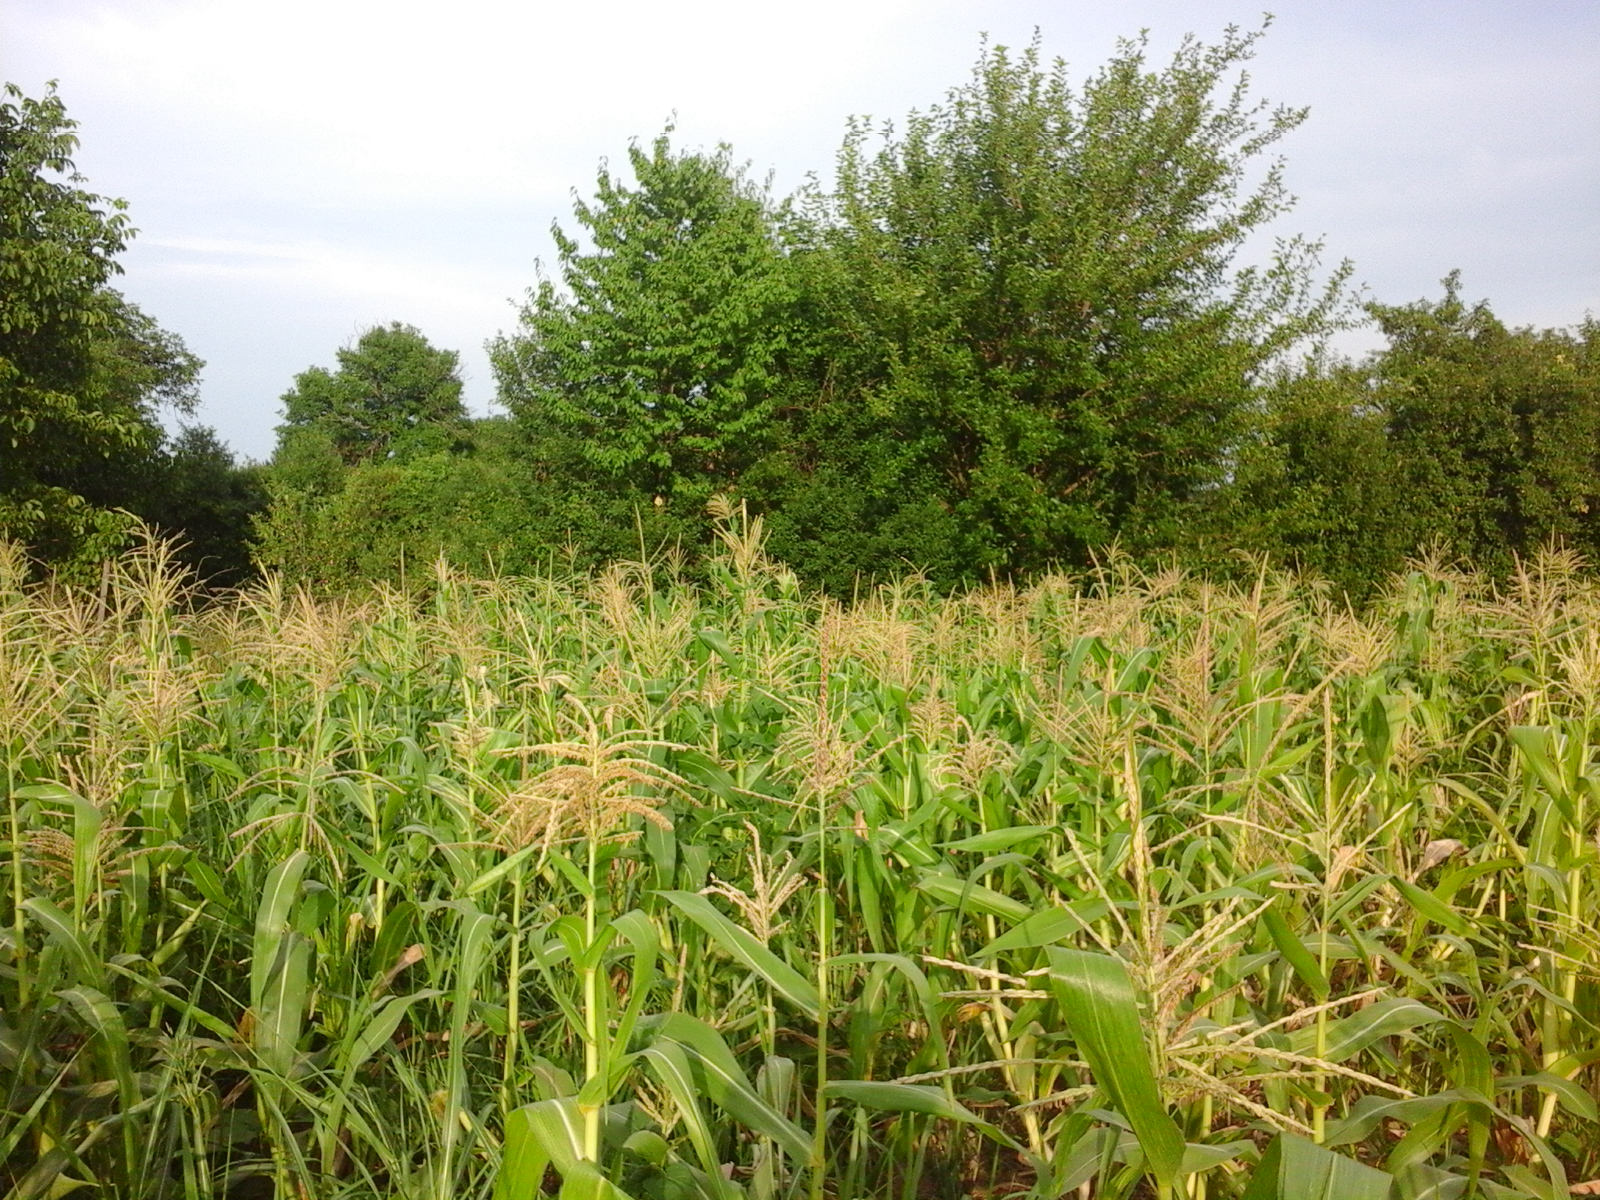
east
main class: Cropland
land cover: Maize
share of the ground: > 75 %
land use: Agriculture (excluding fallow land and kitchen gardens)
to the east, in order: Maize; Abandoned hedges; Fences; Maize; Abandoned hedges; Fences; Lucerne; Spontaneously vegetated surfaces; Abandoned hedges; Grassland without tree/shrub cover; Abandoned hedges; Artificial constructions in urban areas; Broadleaved woodland; Artificial constructions in urban areas
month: July
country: RO
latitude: 46.1966
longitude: 26.7378
